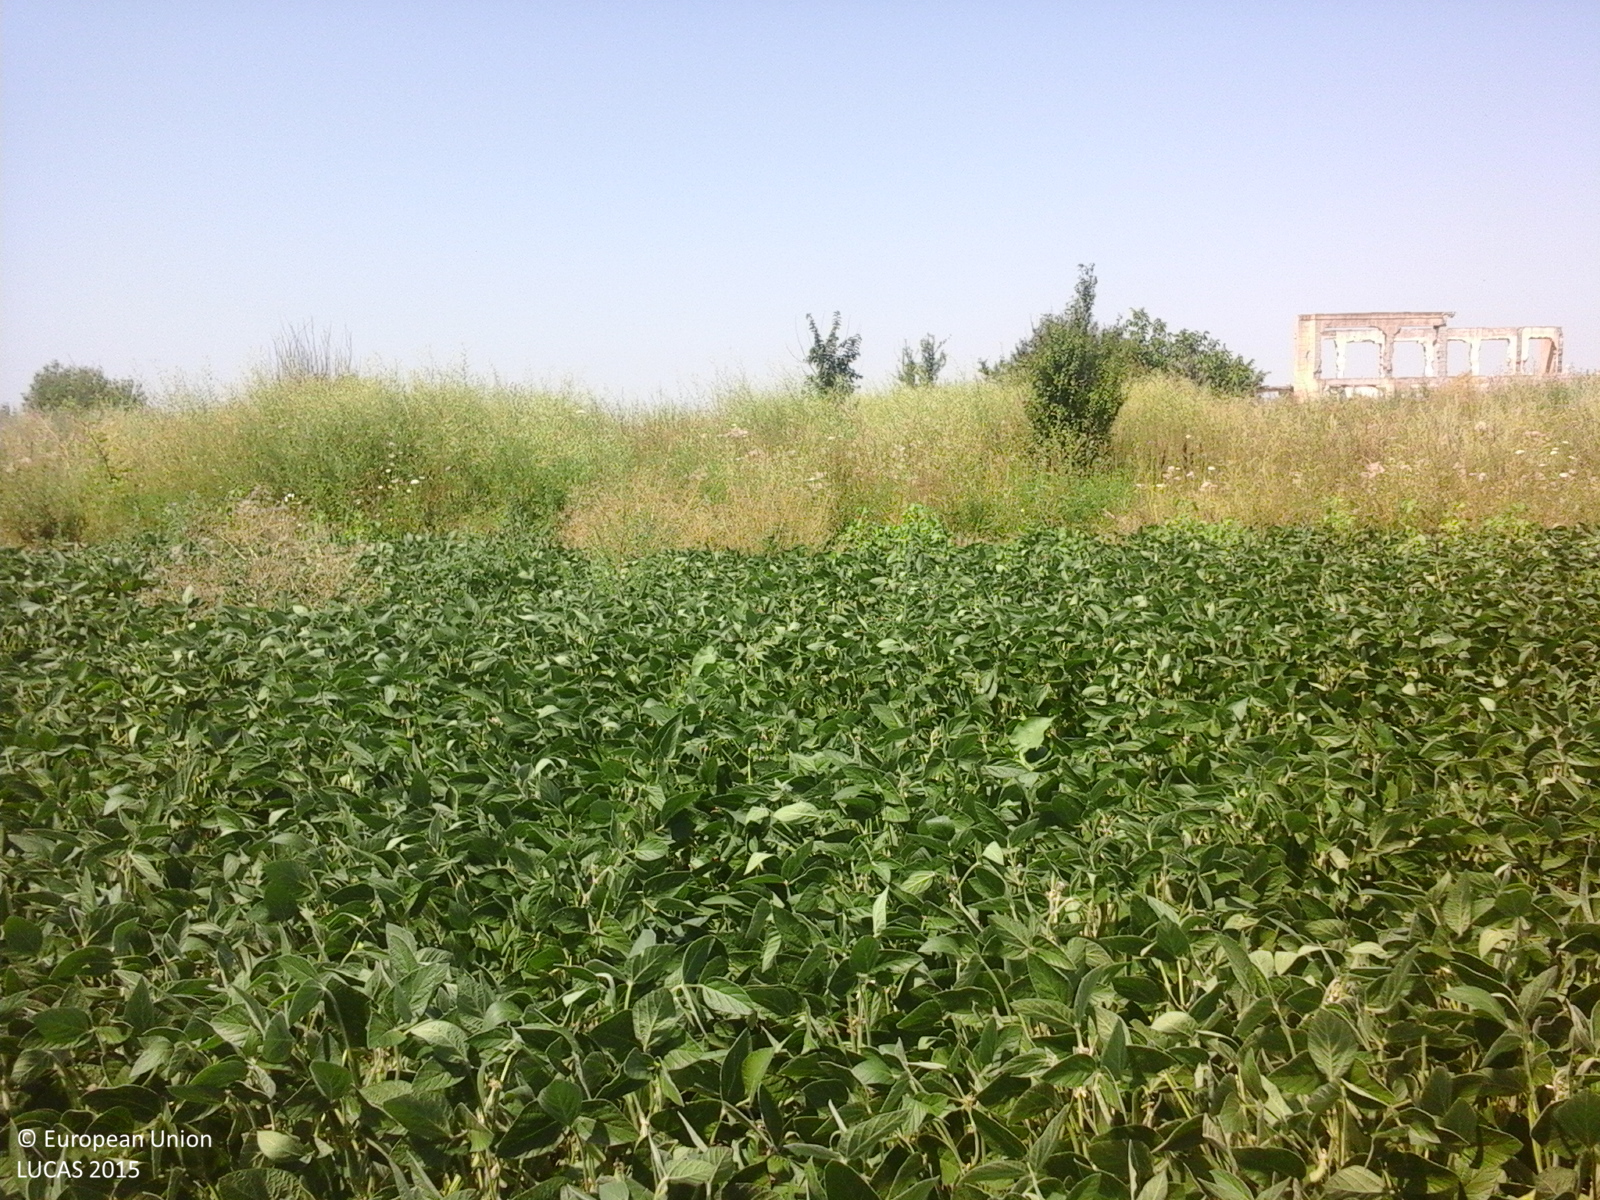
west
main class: Cropland
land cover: Soya
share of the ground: > 75 %
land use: Agriculture (excluding fallow land and kitchen gardens)
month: July
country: RO
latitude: 44.1822
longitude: 27.0260
